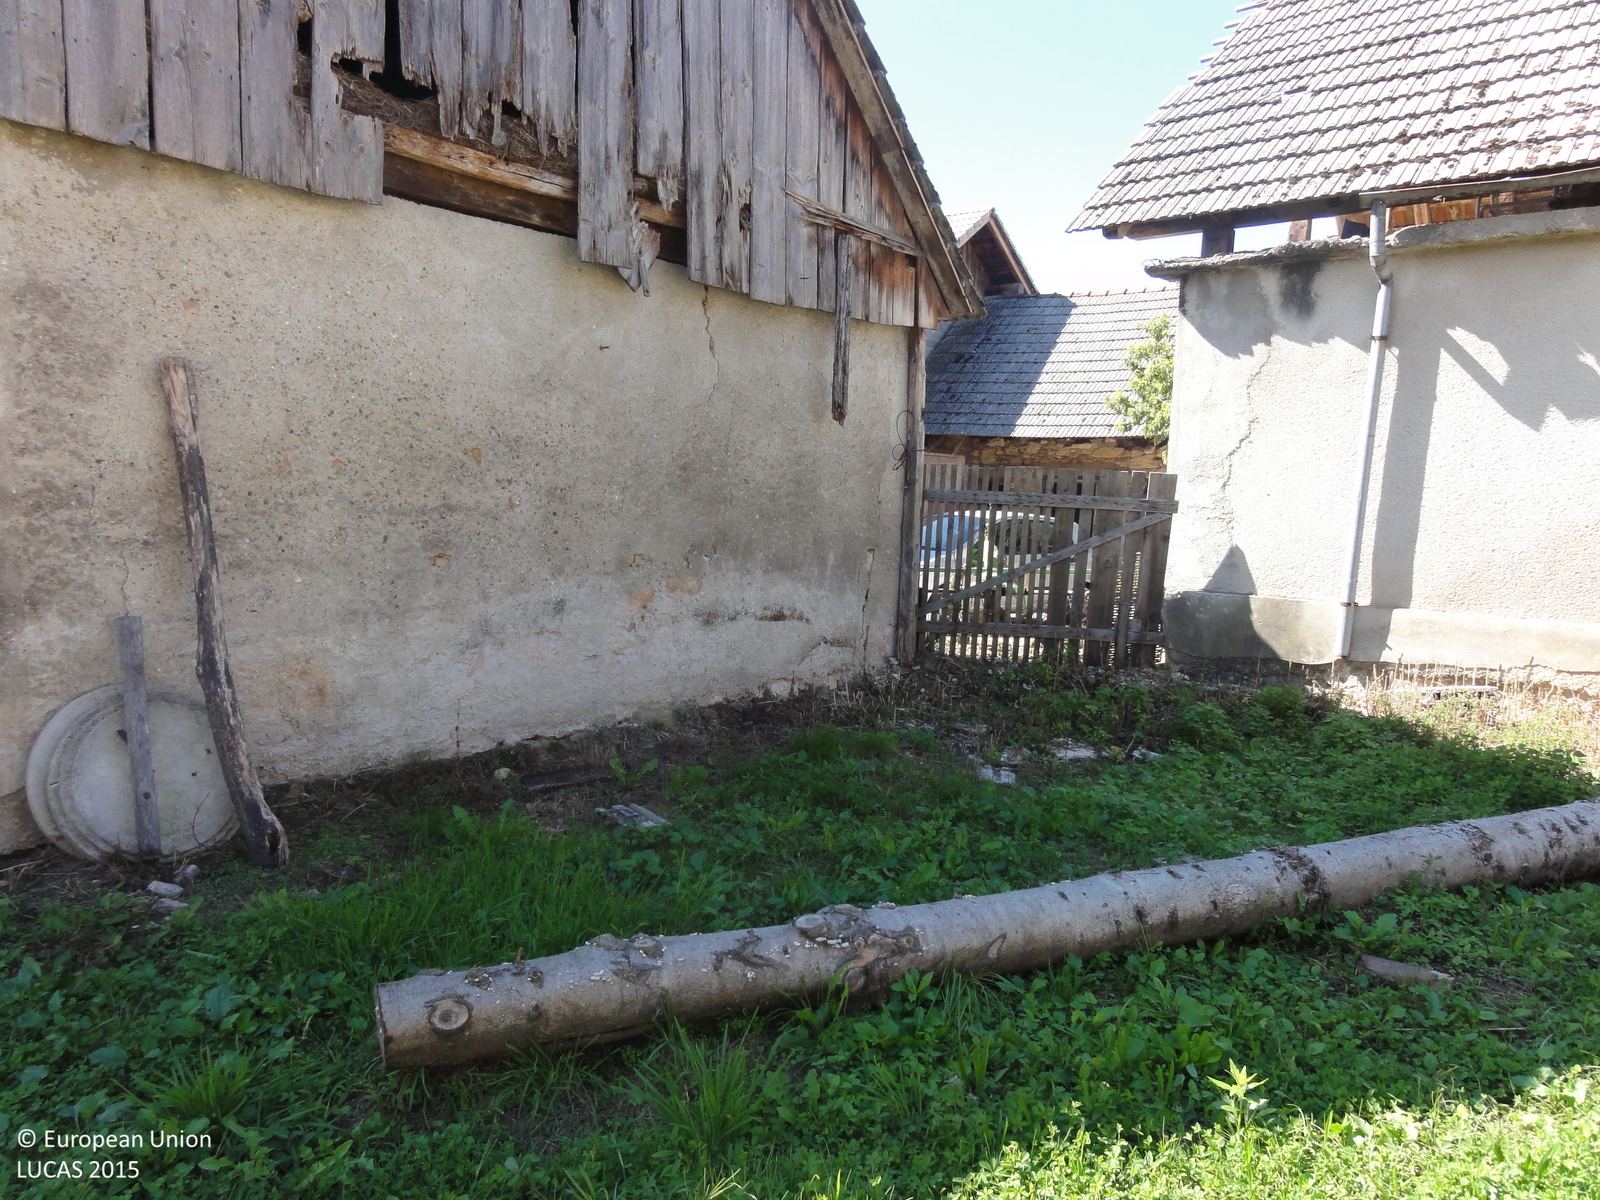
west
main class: Grassland
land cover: Grassland without tree/shrub cover
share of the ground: > 75 %
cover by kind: herbaceous plants 100 %
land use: Residential
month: September
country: SI
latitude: 45.8695
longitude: 15.4462
